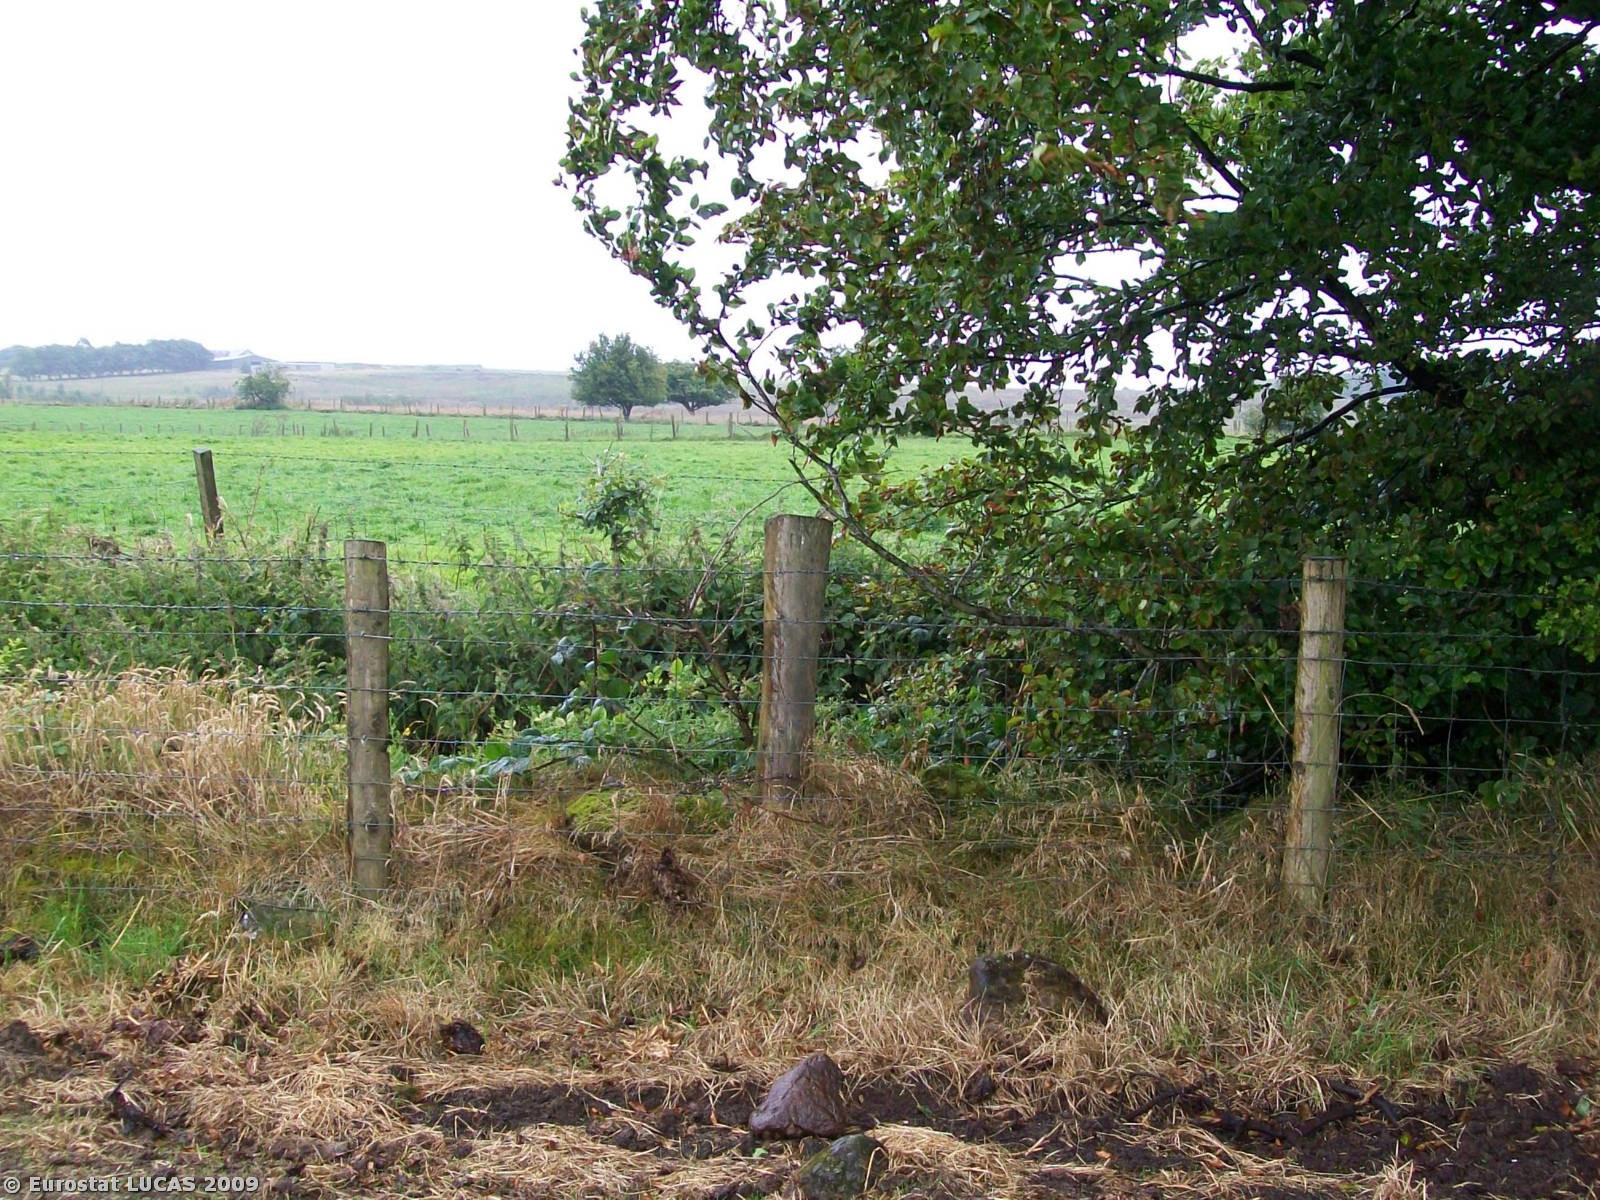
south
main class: Grassland
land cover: Grassland without tree/shrub cover
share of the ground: 10 - 25 %
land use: Agriculture (excluding fallow land and kitchen gardens)
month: July
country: GB
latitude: 54.8572
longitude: -6.1742
